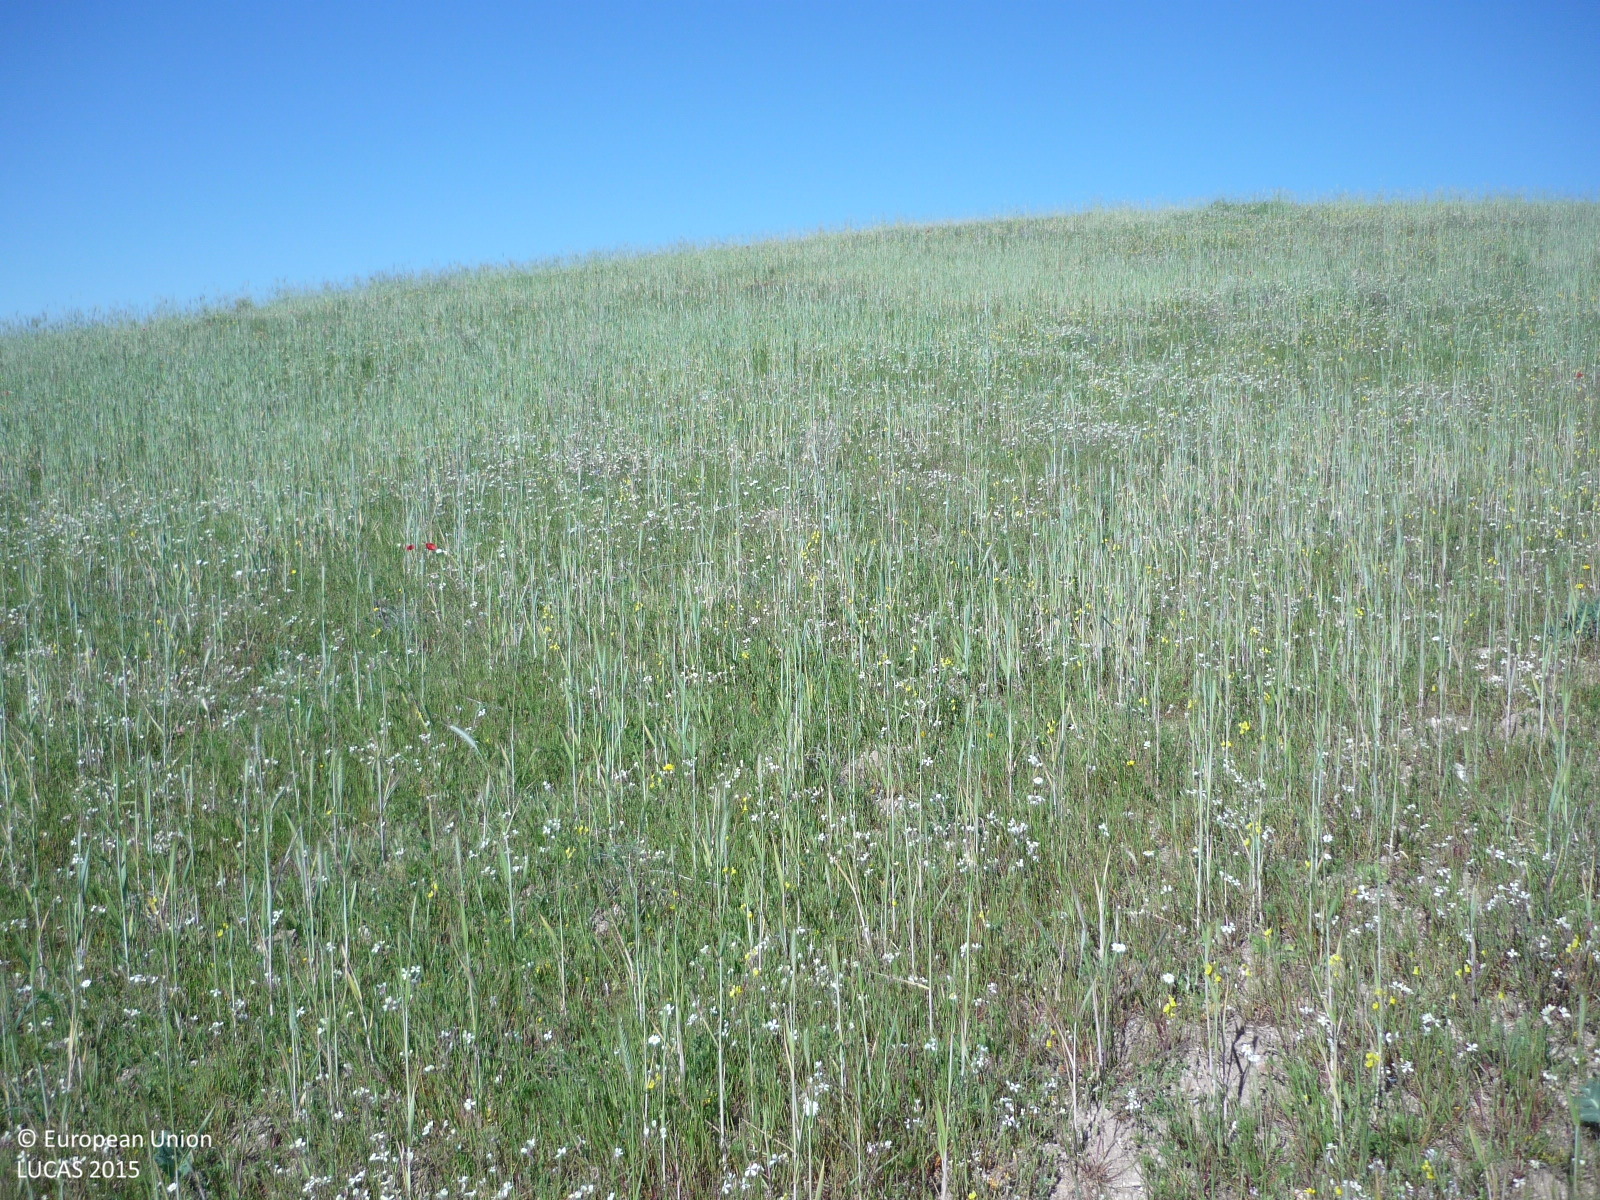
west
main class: Grassland
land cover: Spontaneously vegetated surfaces
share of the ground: > 75 %
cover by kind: herbaceous plants 90 %, unconsolidated bare surface 10 %
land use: Fallow land
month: April
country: ES
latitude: 40.6550
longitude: -3.5809
